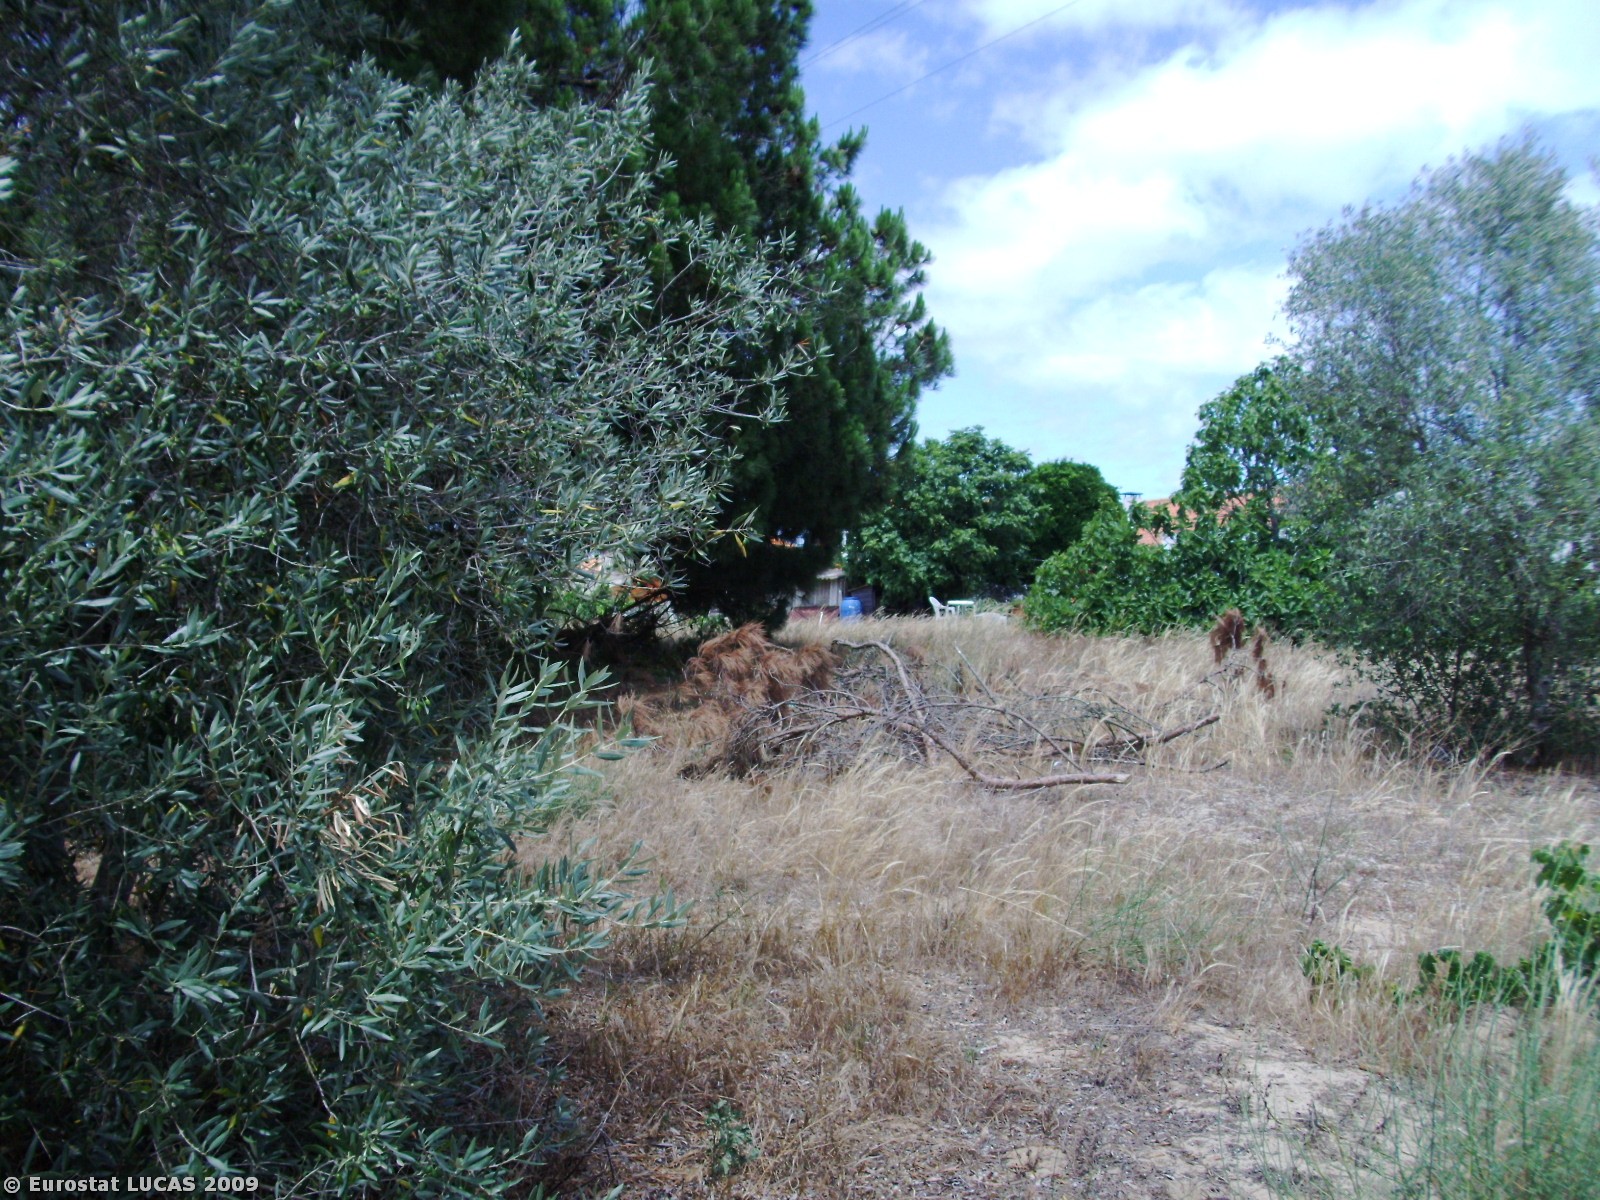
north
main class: Cropland
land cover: Olive groves
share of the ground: 10 - 25 %
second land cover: Spontaneously vegetated surfaces
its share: 50 - 75 %
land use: Agriculture (excluding fallow land and kitchen gardens)
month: June
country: PT
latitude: 38.1484
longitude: -8.7320
